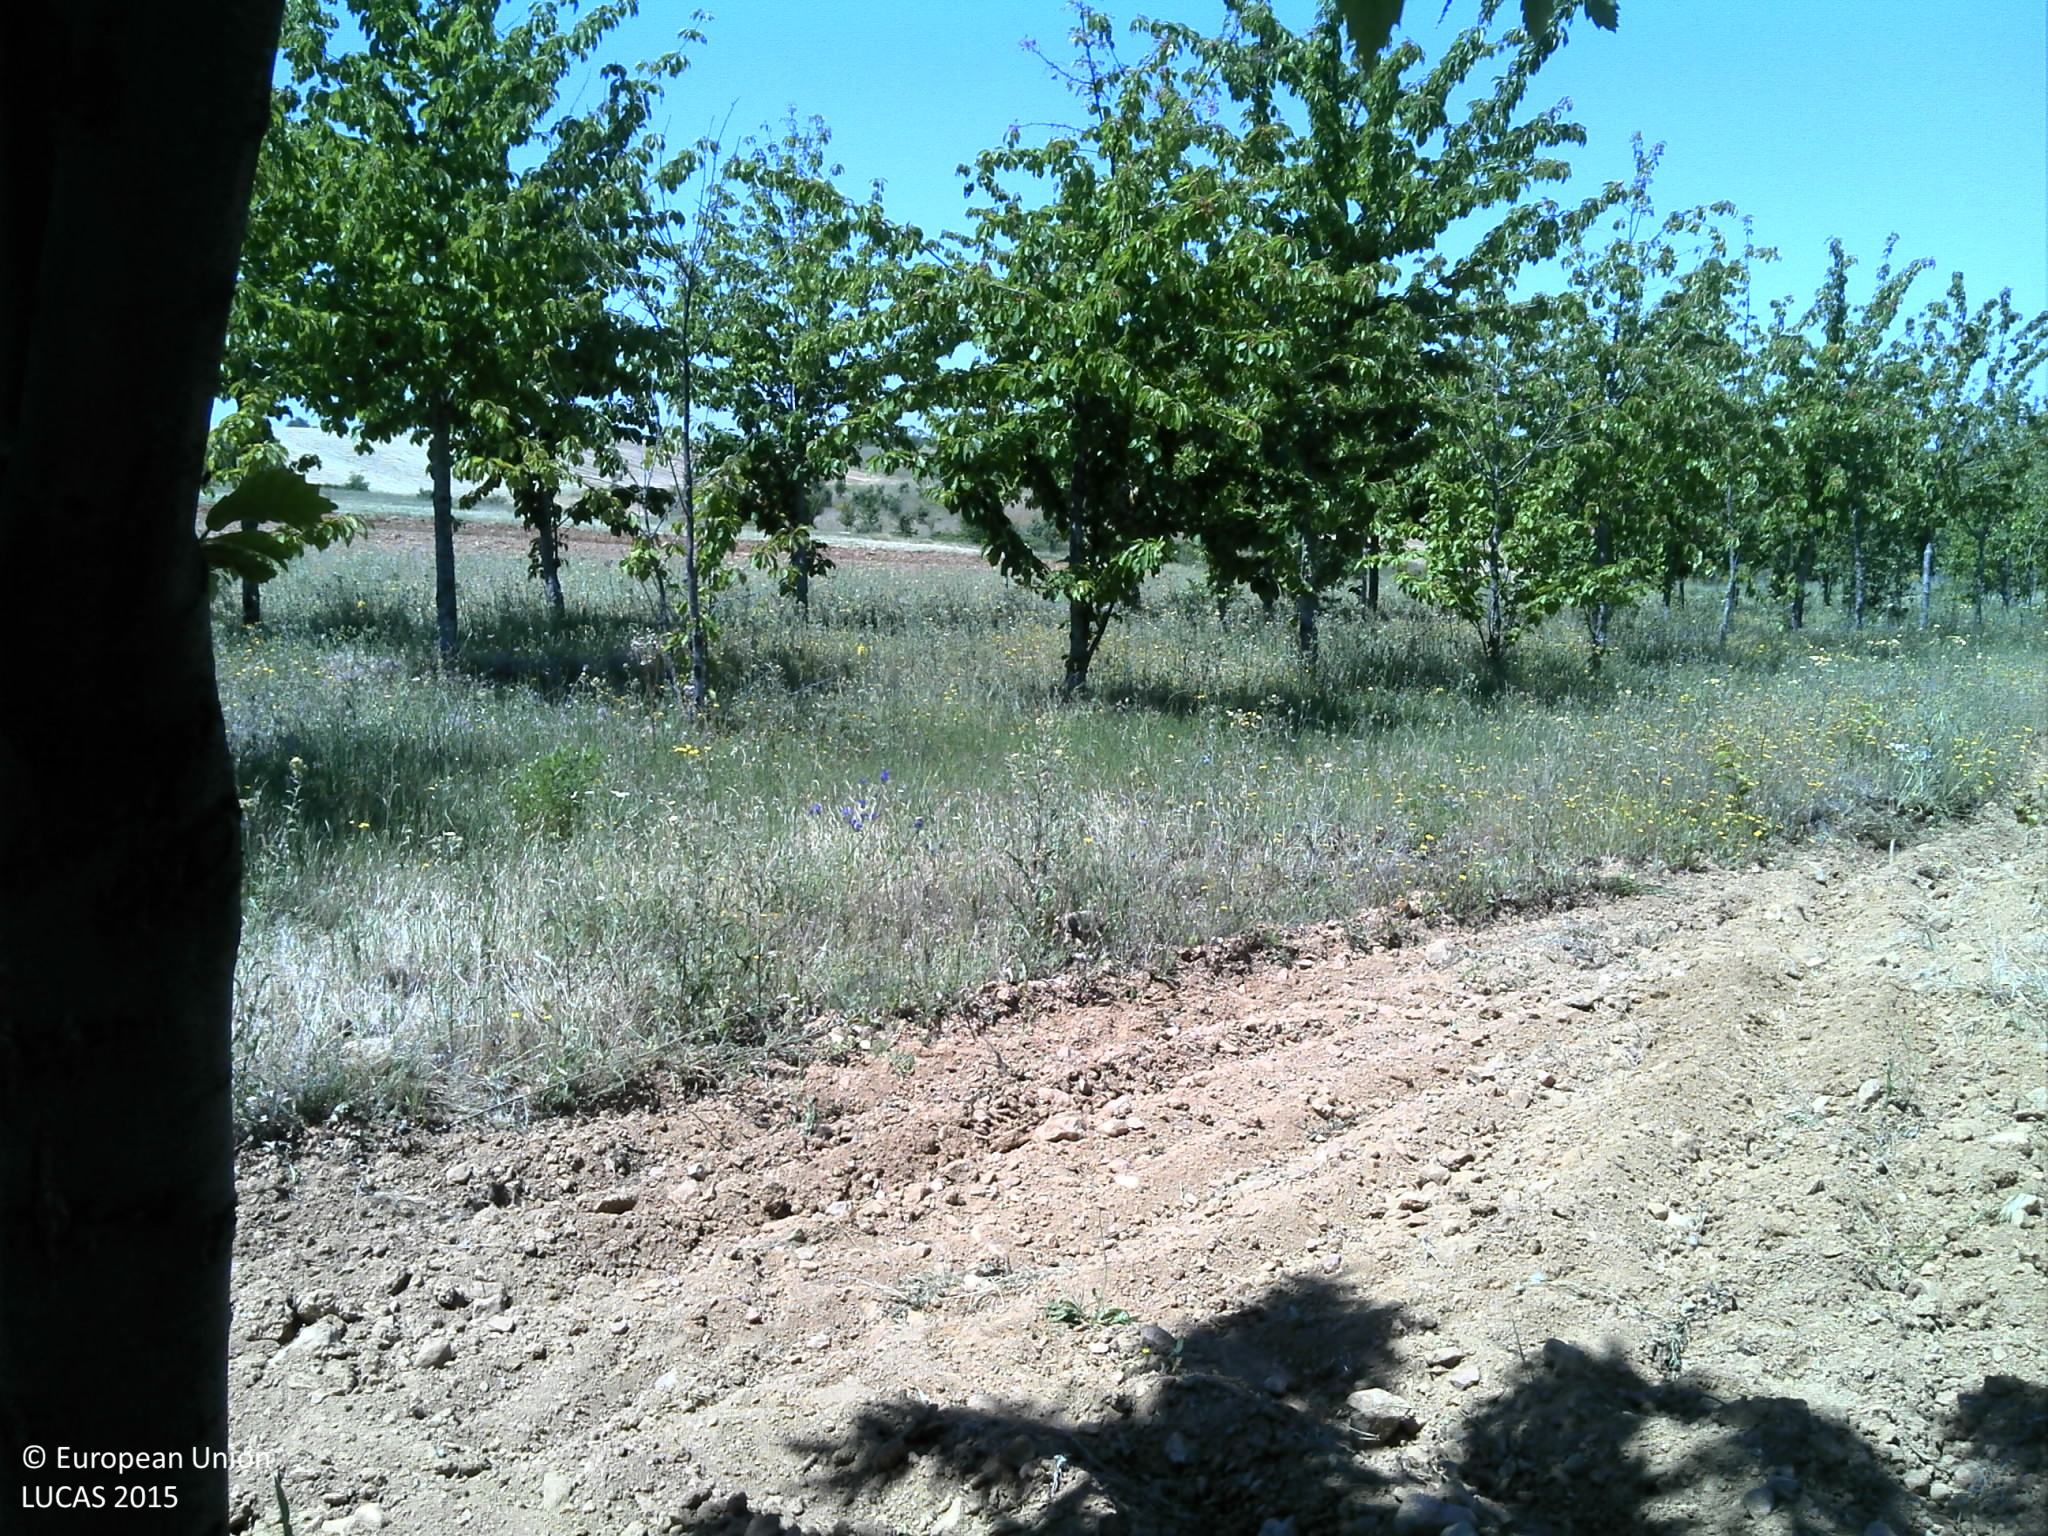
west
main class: Cropland
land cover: Nuts trees
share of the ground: 10 - 25 %
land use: Agriculture (excluding fallow land and kitchen gardens)
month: May
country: PT
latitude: 41.5293
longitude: -6.3880
